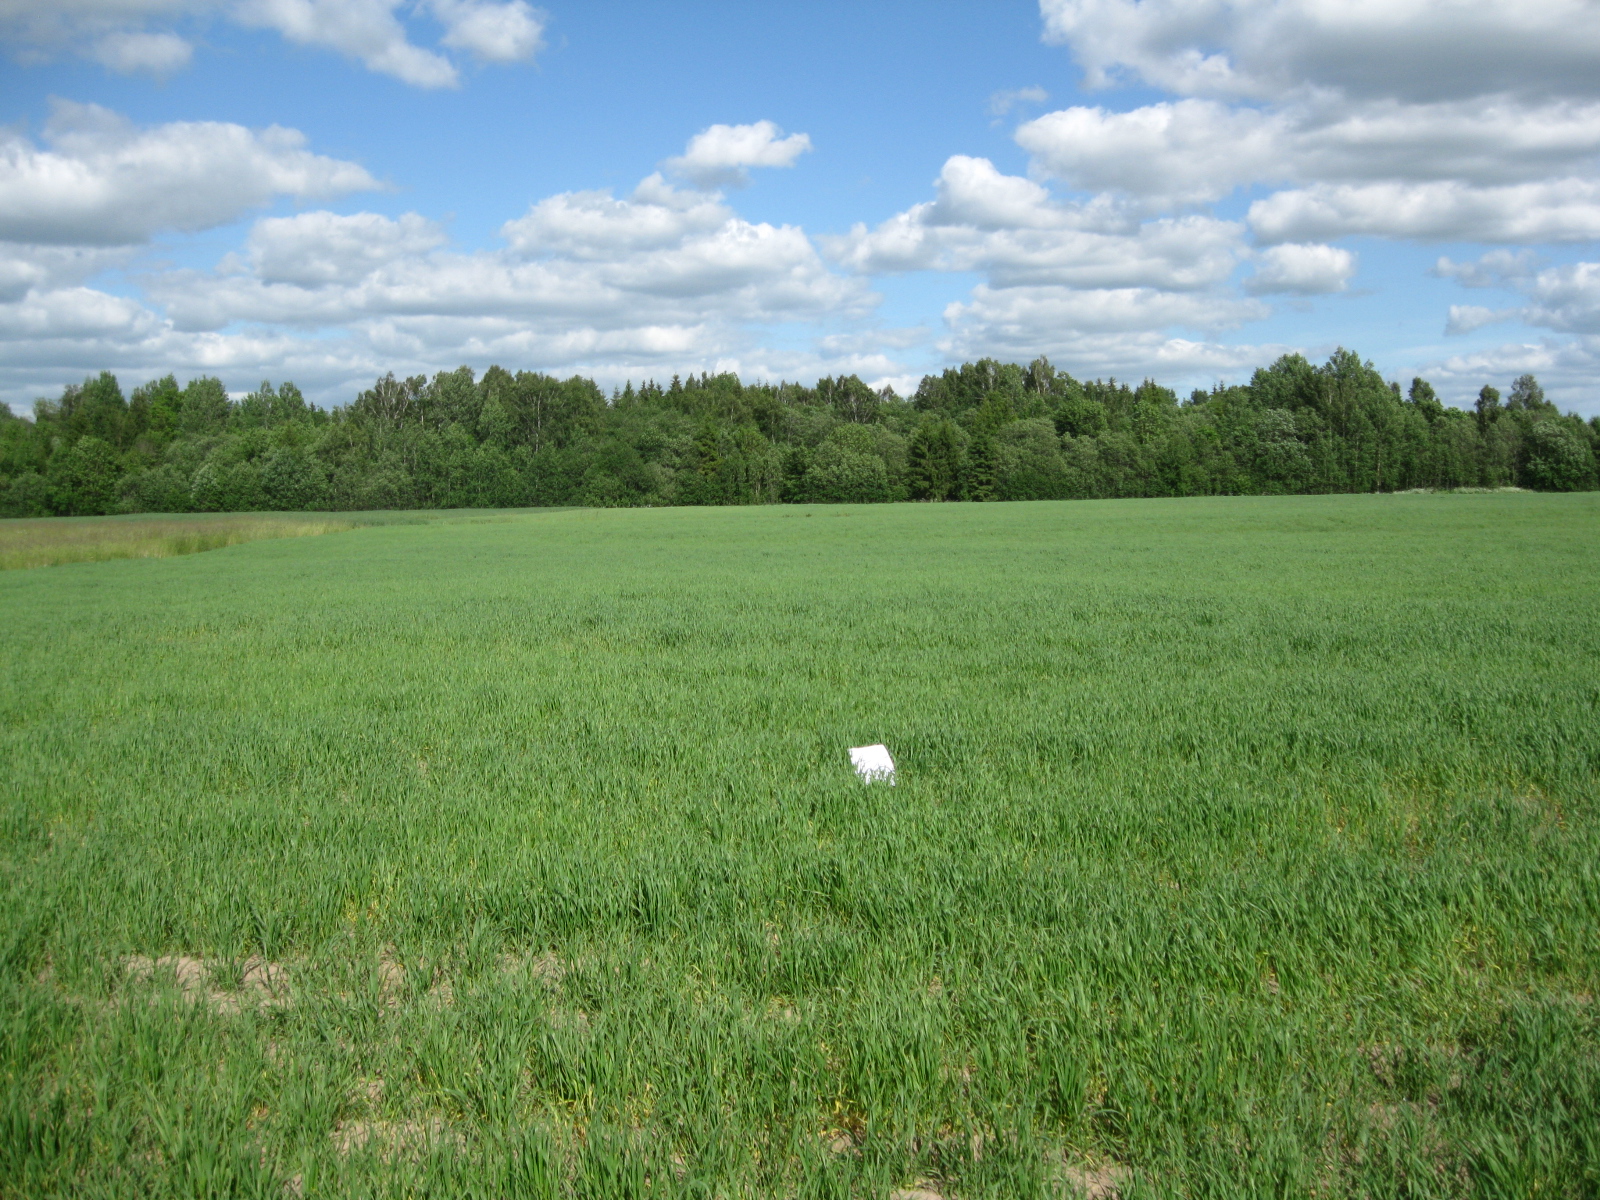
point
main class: Cropland
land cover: Triticale
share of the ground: > 75 %
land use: Agriculture (excluding fallow land and kitchen gardens)
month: June
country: LT
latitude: 55.6274
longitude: 23.5637
